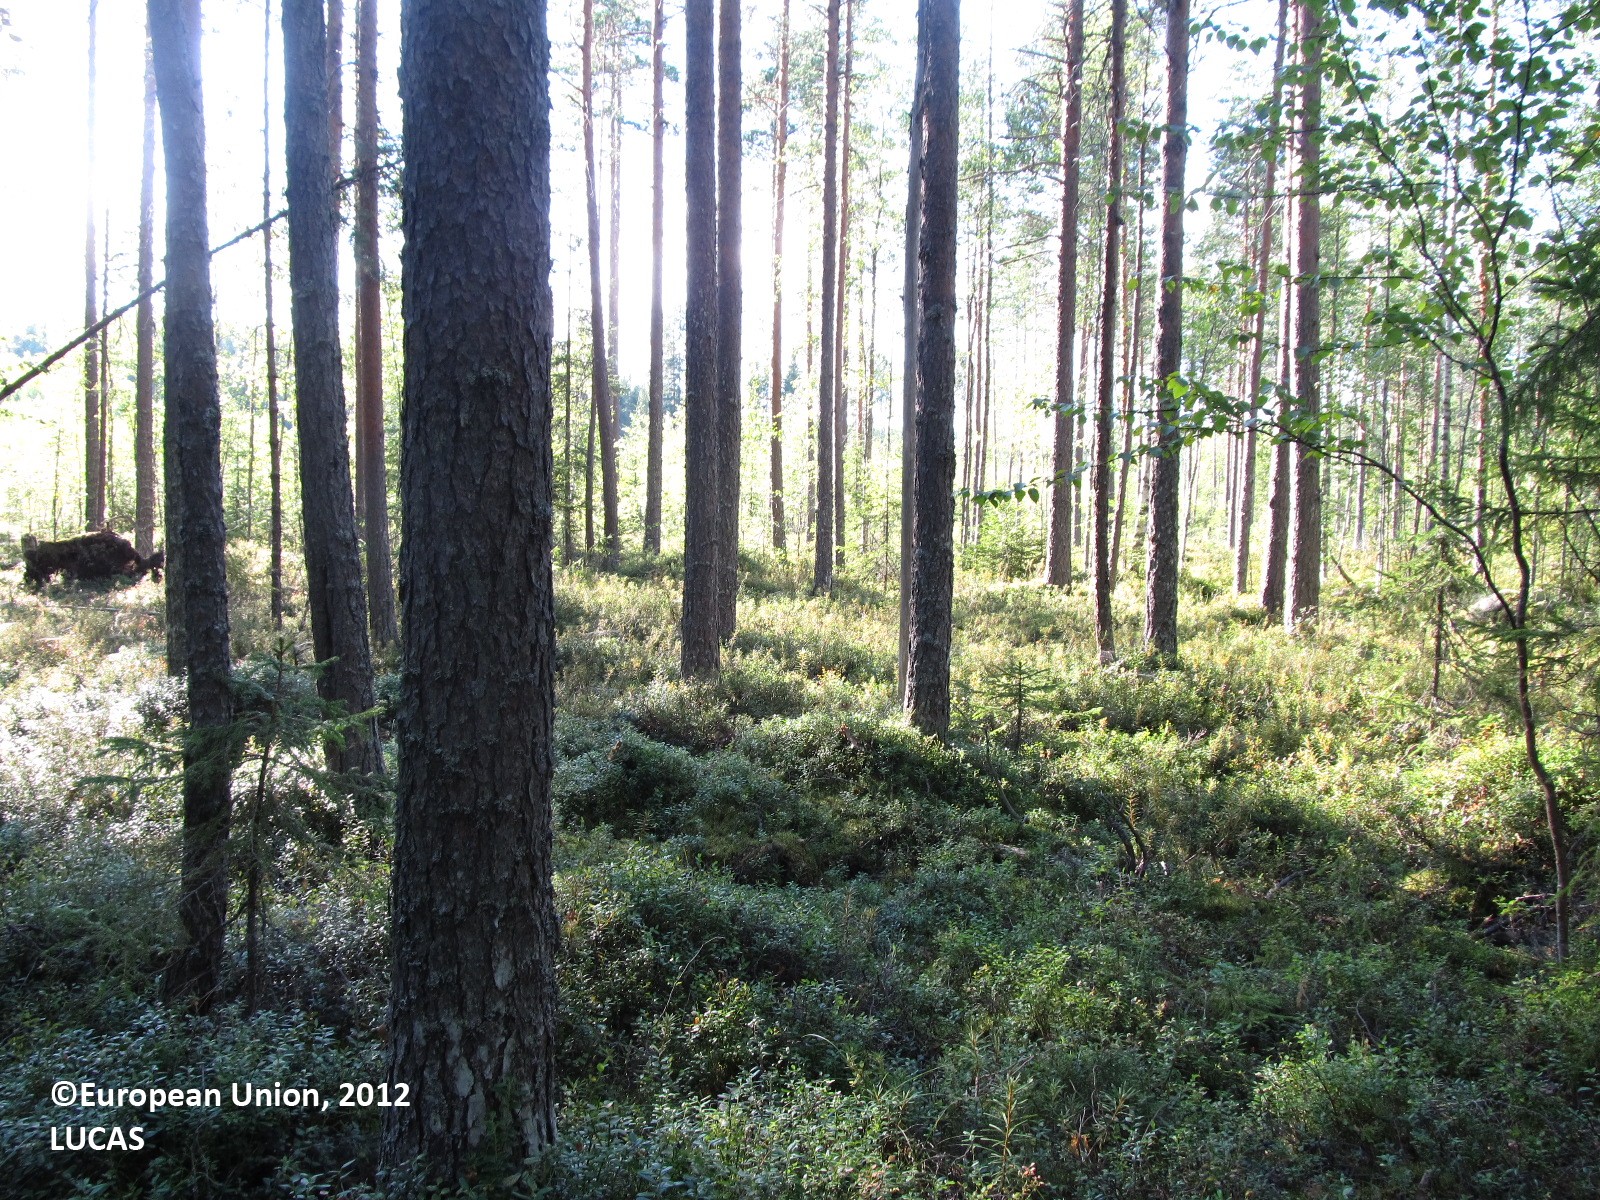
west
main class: Woodland
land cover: Pine dominated mixed woodland
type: boreal forest
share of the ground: 25 - 50 %
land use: Forestry
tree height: > 5 m
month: August
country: FI
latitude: 62.1410
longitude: 27.5719
